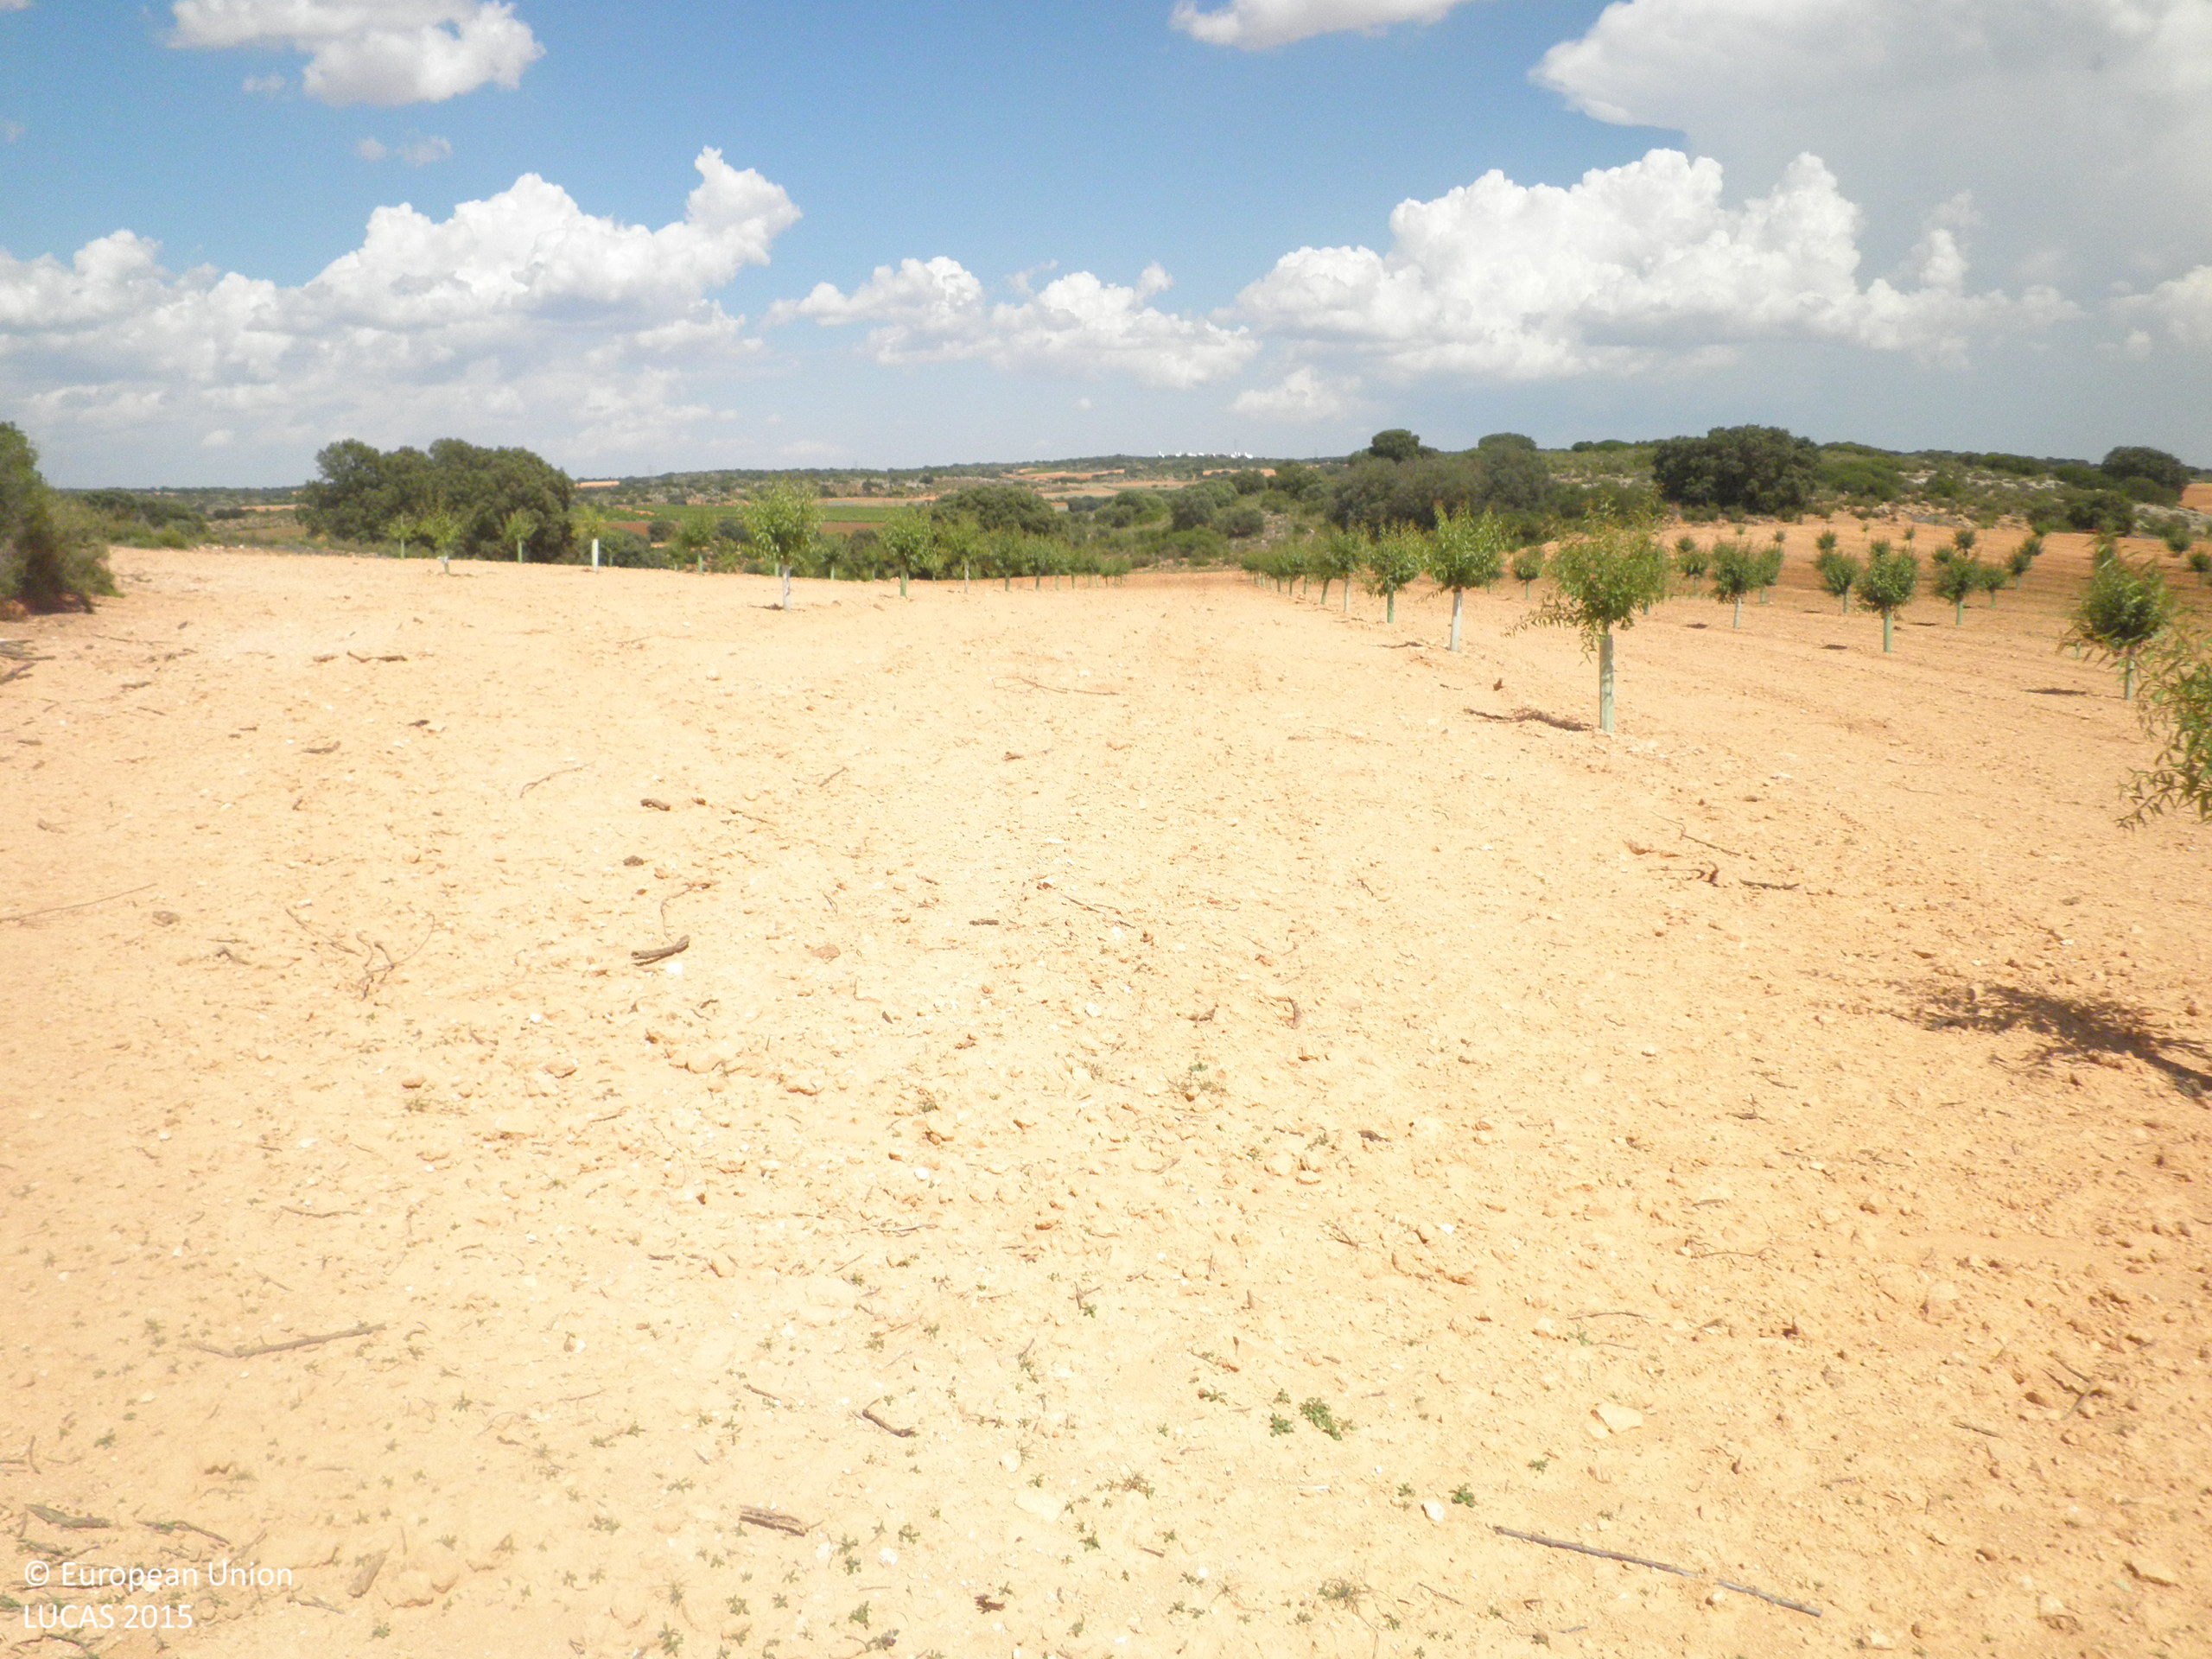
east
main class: Cropland
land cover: Nuts trees
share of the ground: < 10 %
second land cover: Other bare soil
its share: > 75 %
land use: Agriculture (excluding fallow land and kitchen gardens)
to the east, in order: Nuts trees; Other bare soil; Broadleaved woodland; Shrubland with sparse tree cover
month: June
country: ES
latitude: 39.4816
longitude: -1.7829
